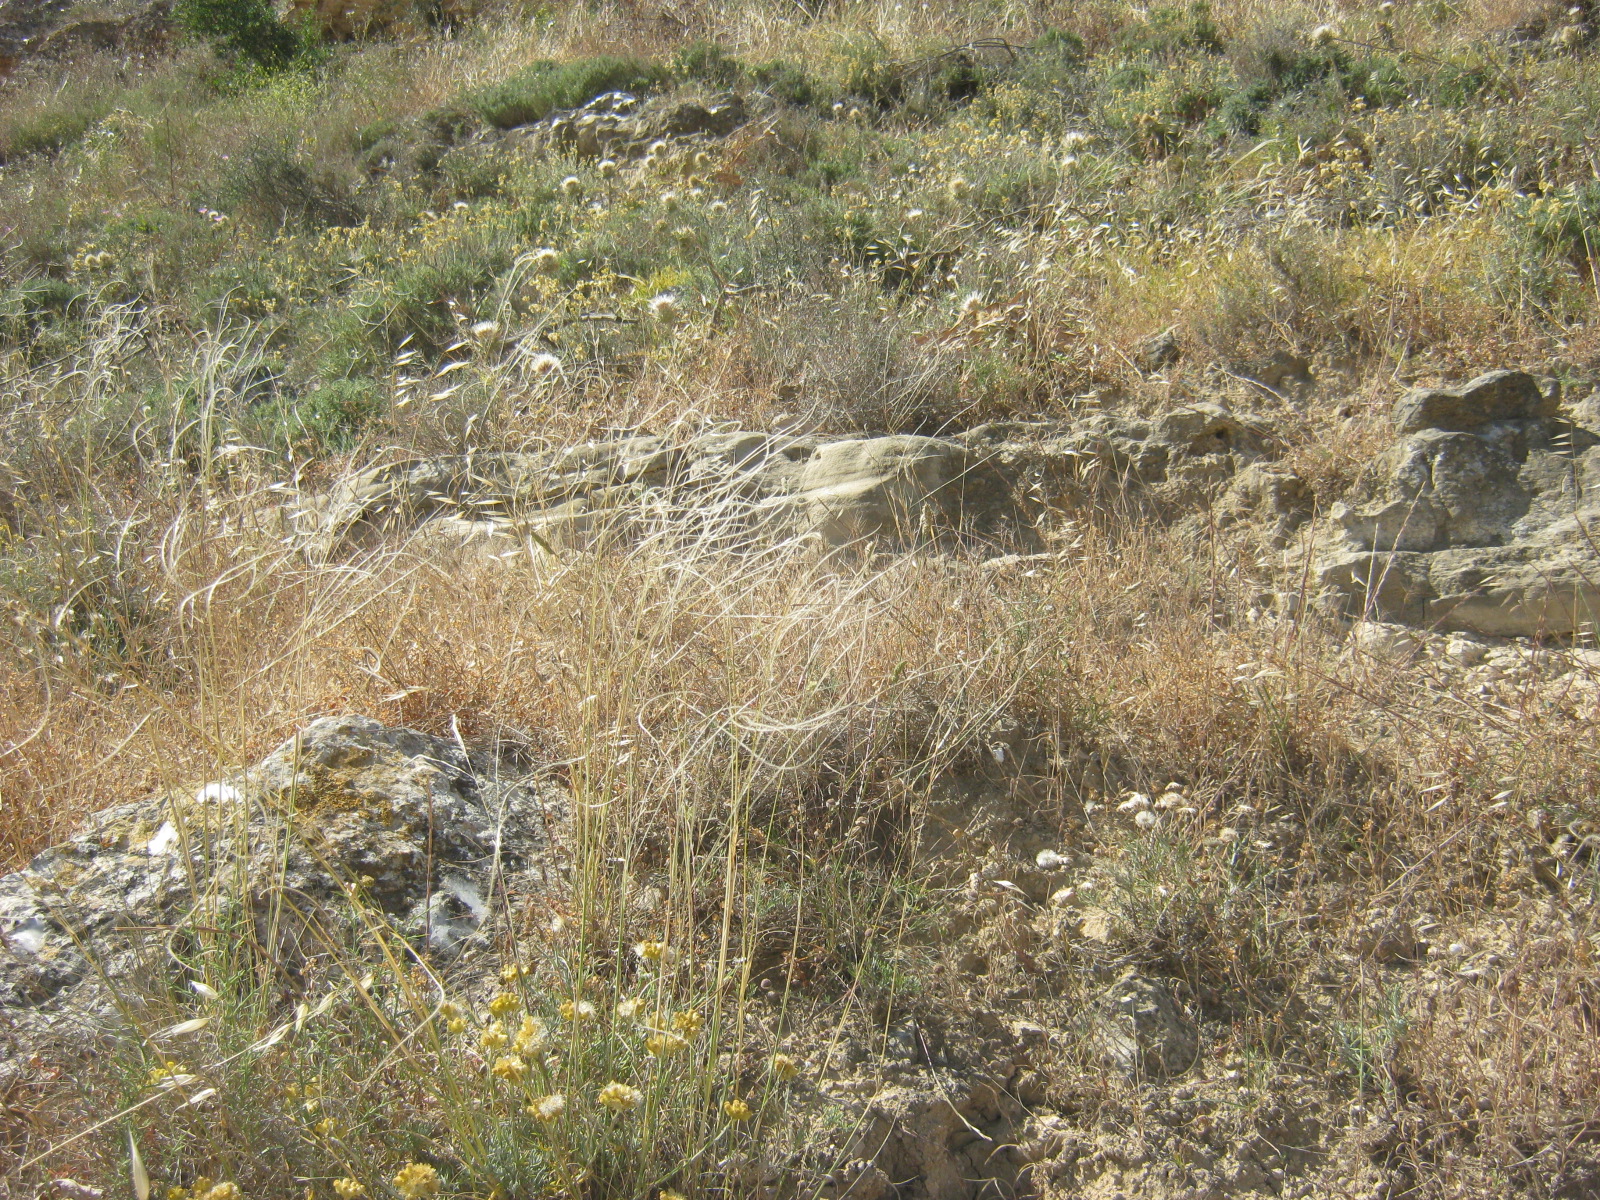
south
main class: Shrubland
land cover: Shrubland without tree cover
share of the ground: 25 - 50 %
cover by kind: unconsolidated bare surface 55 %, shrubs 40 %, herbaceous plants 5 %
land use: Semi-natural and natural areas not in use
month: May
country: CY
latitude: 35.1655
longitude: 33.2334
